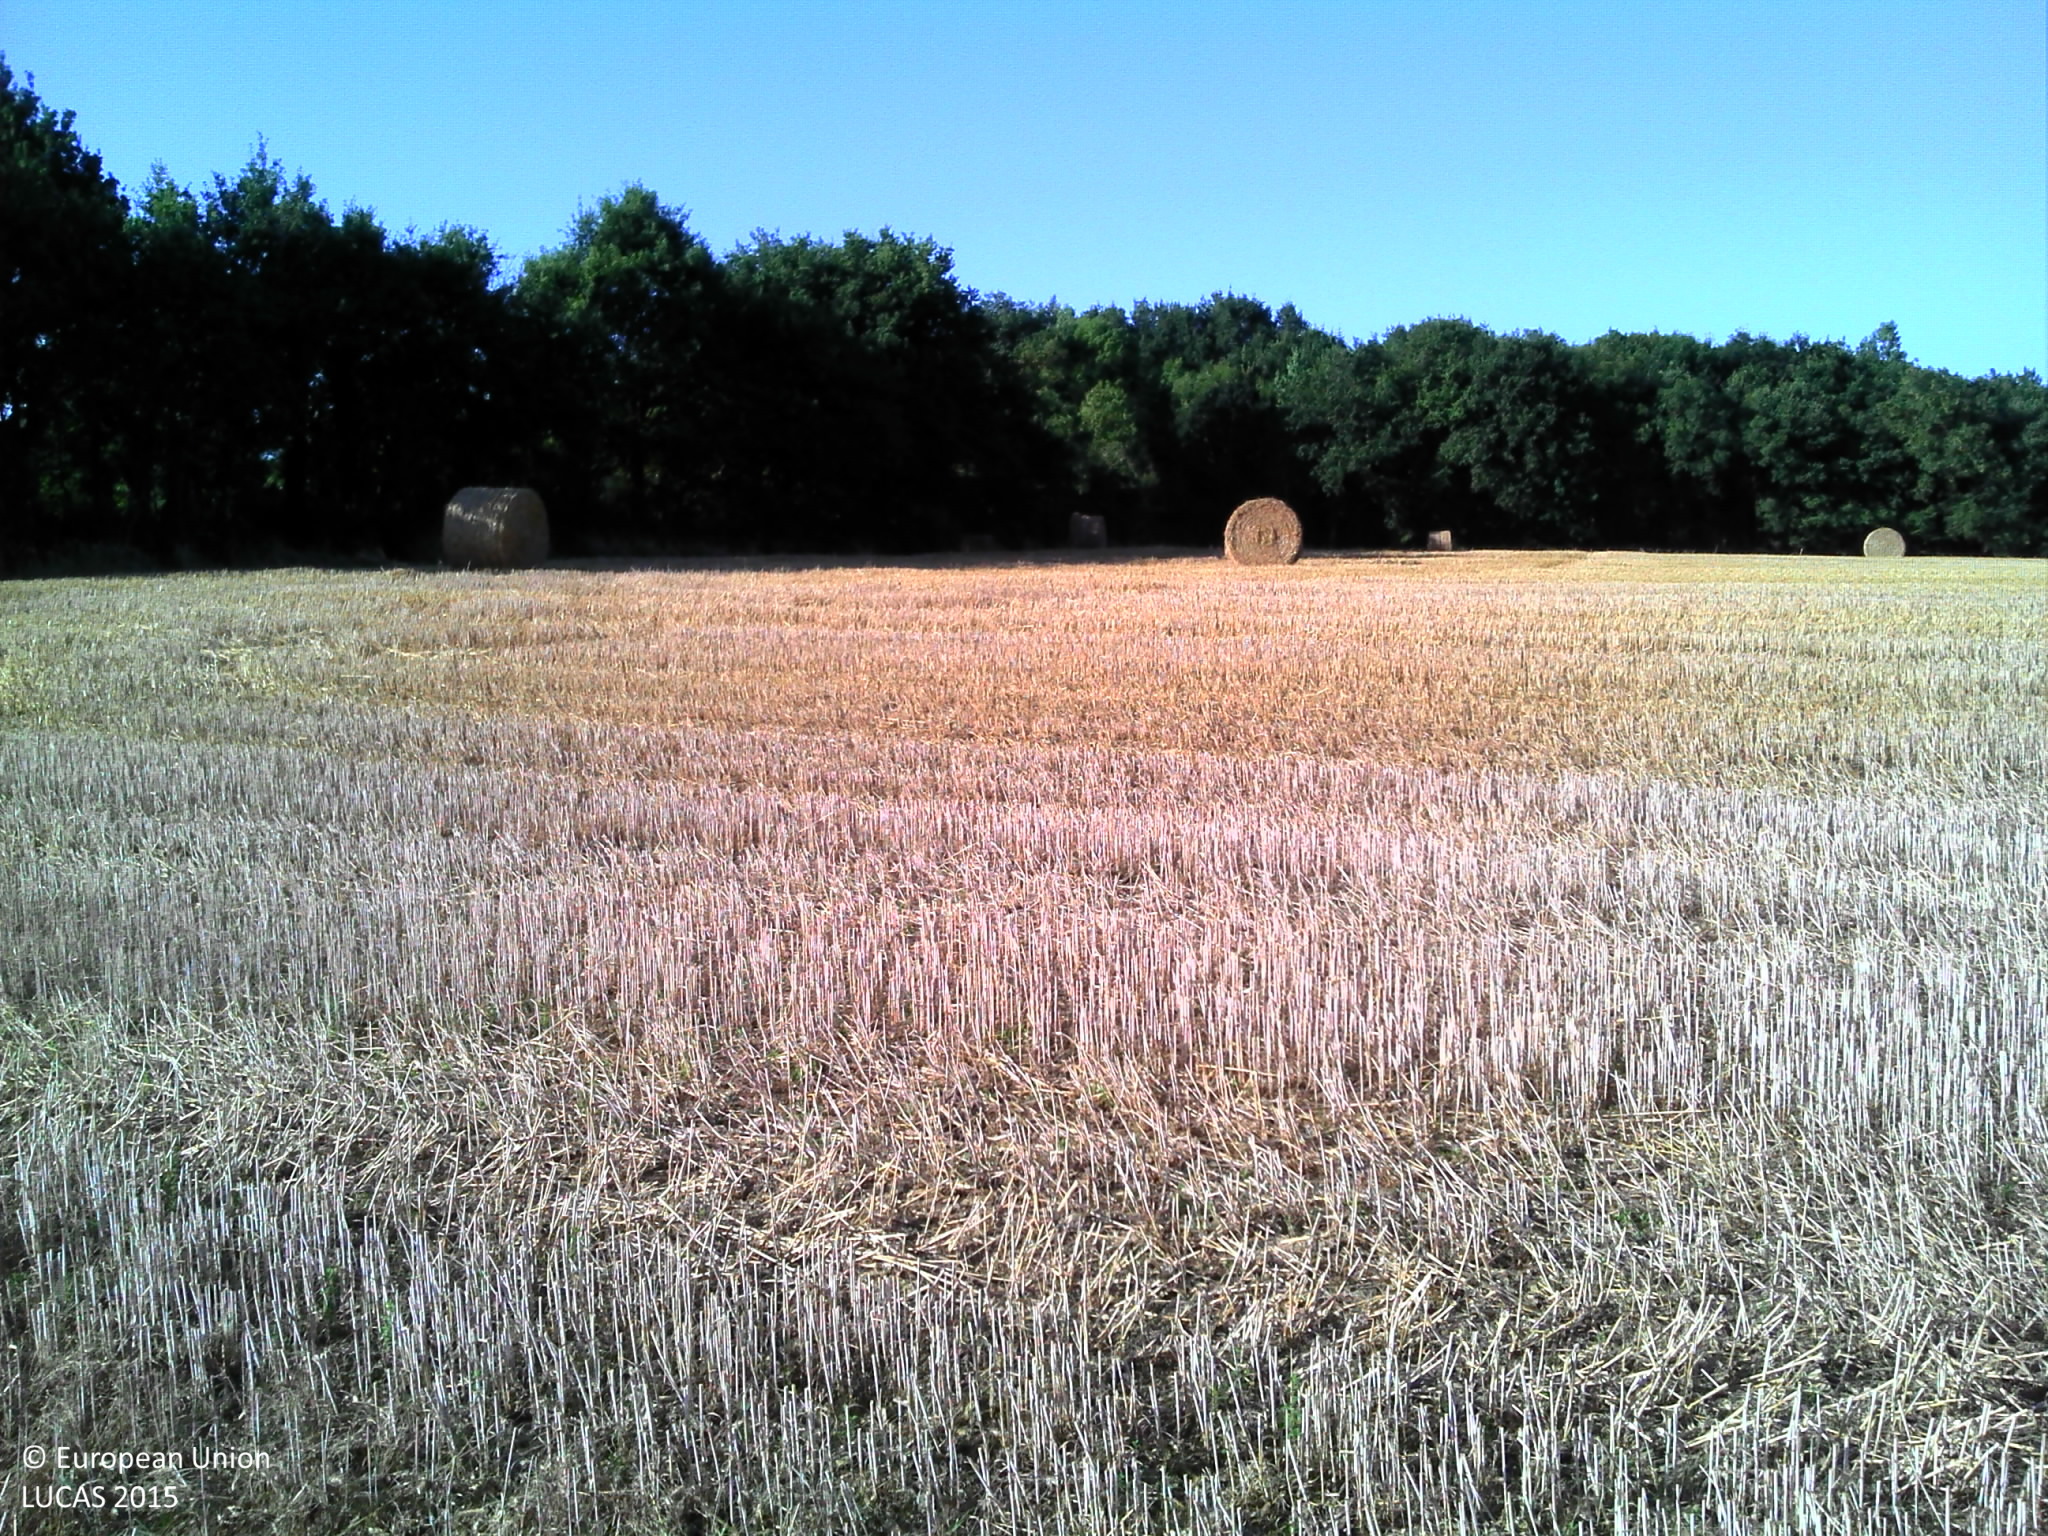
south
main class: Cropland
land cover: Triticale
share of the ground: > 75 %
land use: Agriculture (excluding fallow land and kitchen gardens)
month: August
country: FR
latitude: 47.0384
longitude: -1.6634
